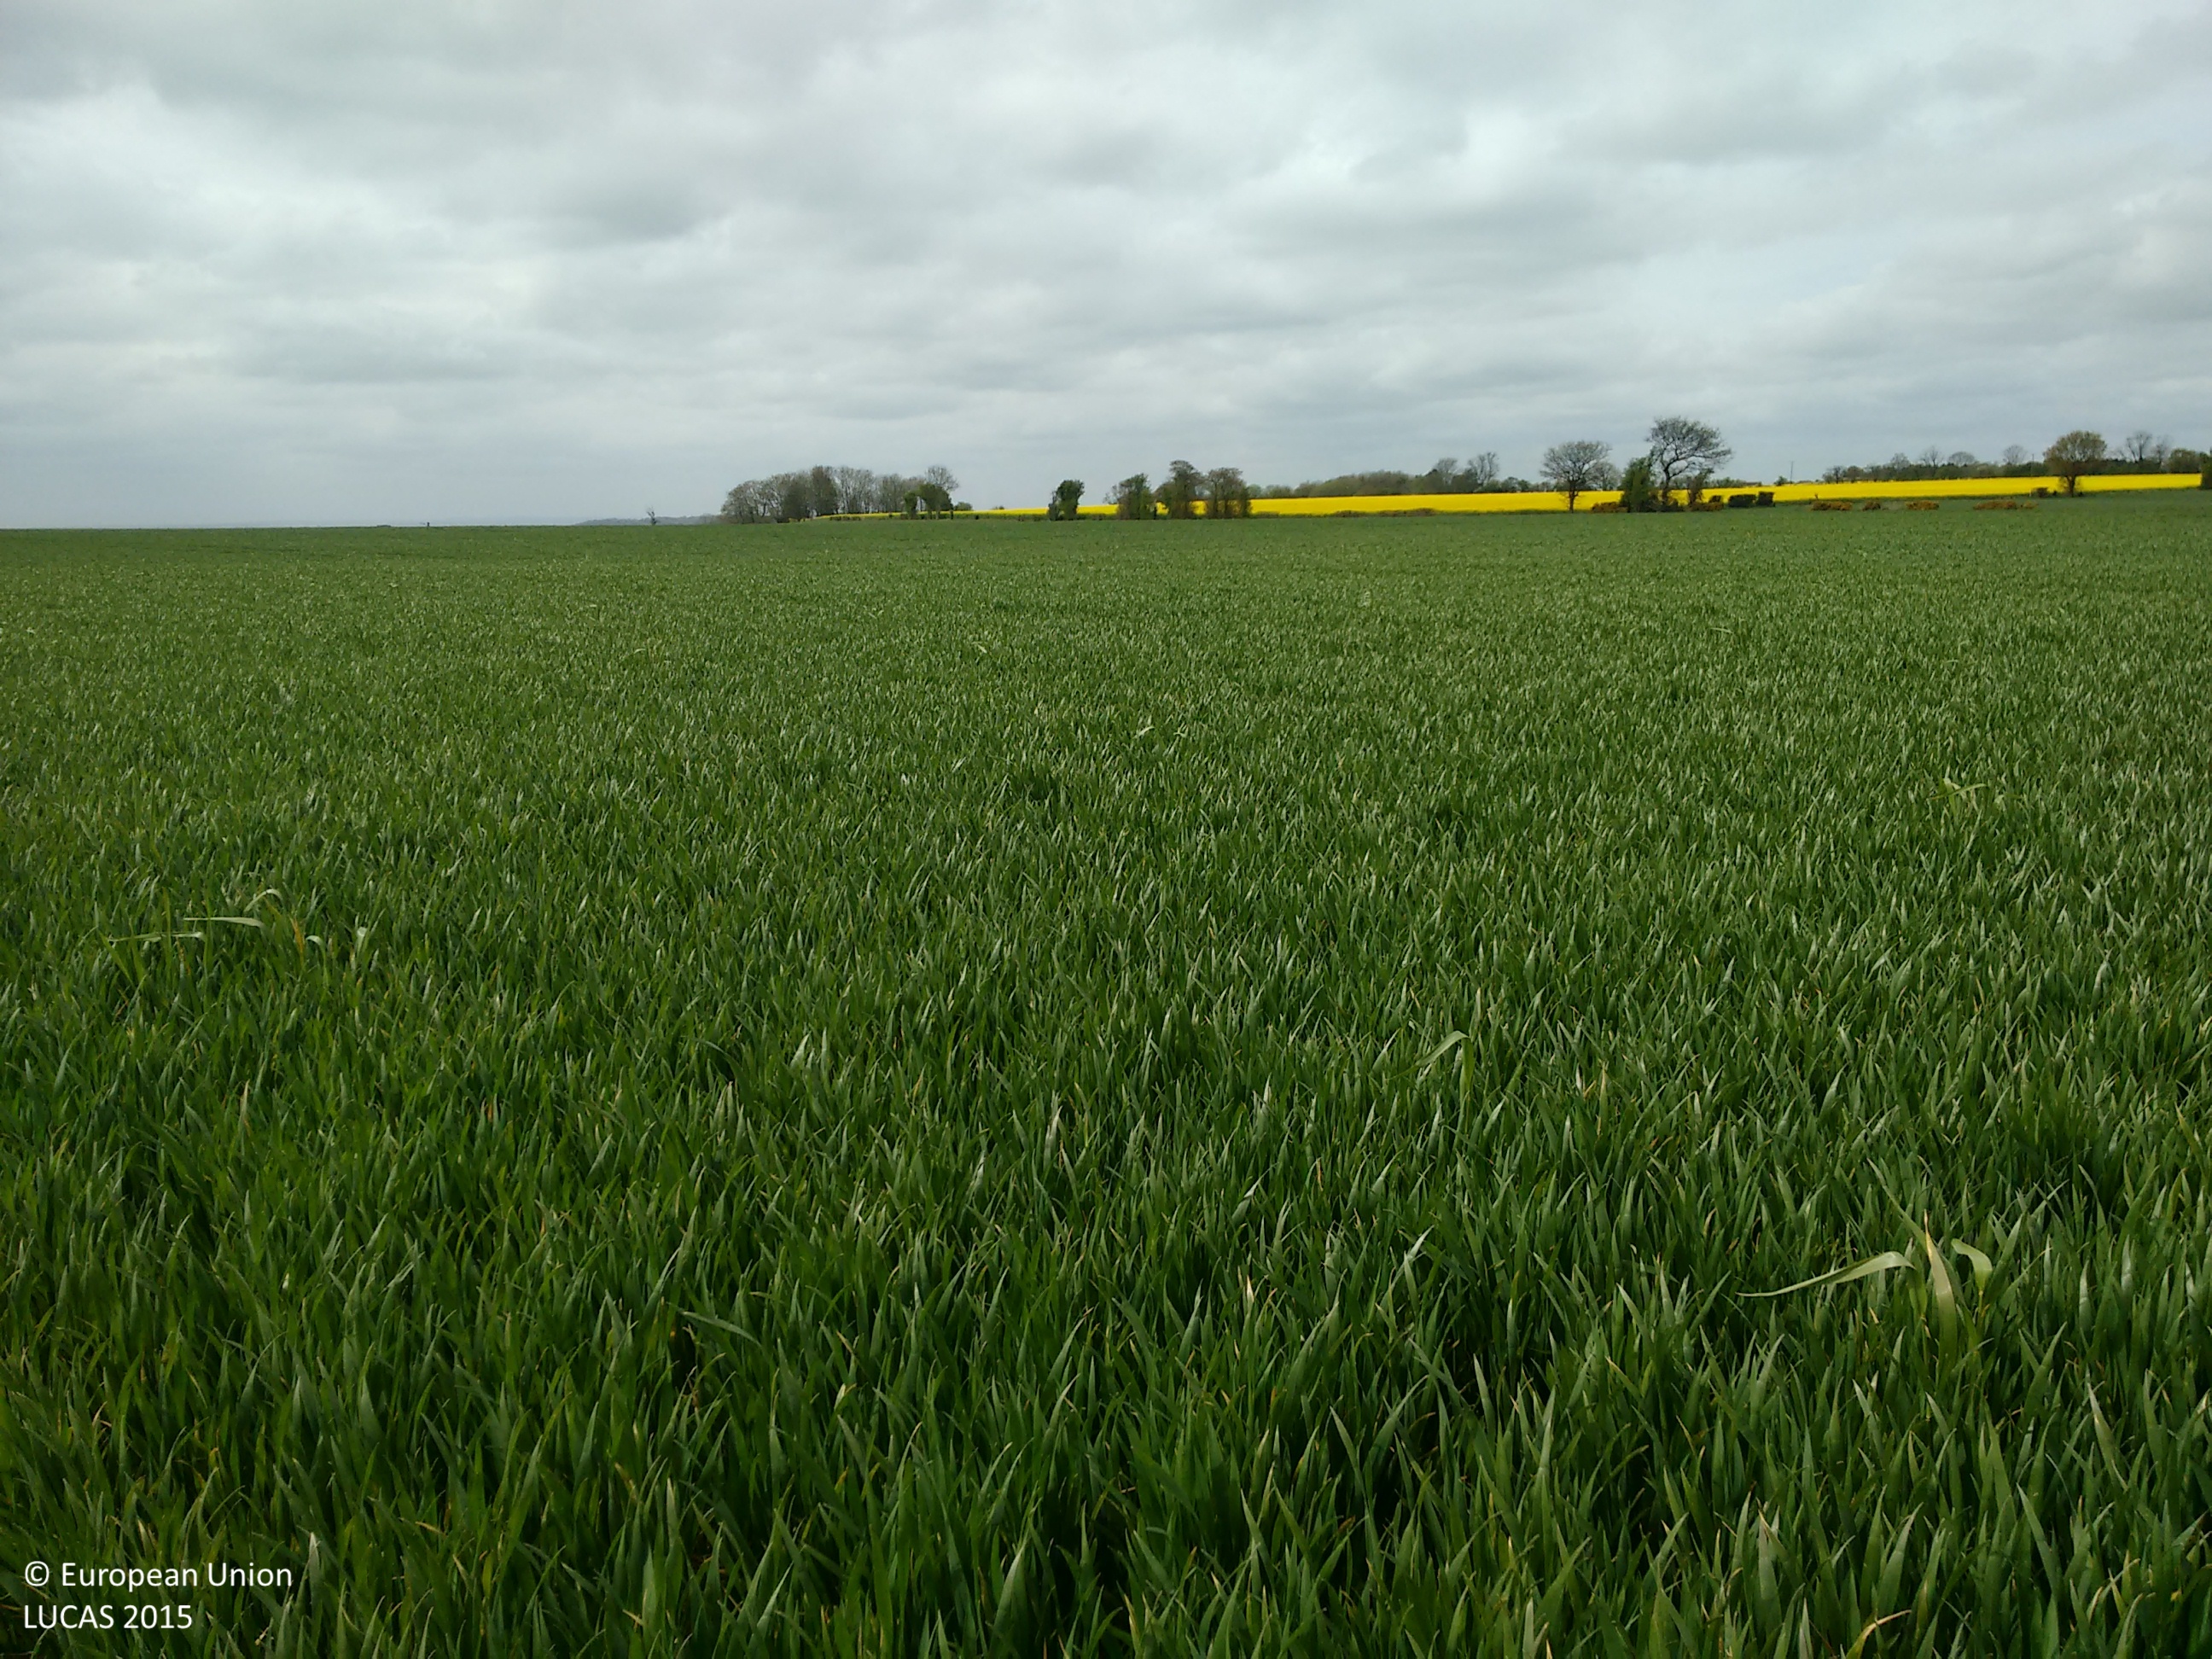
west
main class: Cropland
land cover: Common wheat
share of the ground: > 75 %
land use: Agriculture (excluding fallow land and kitchen gardens)
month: May
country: GB
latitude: 51.2386
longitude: 0.7646
